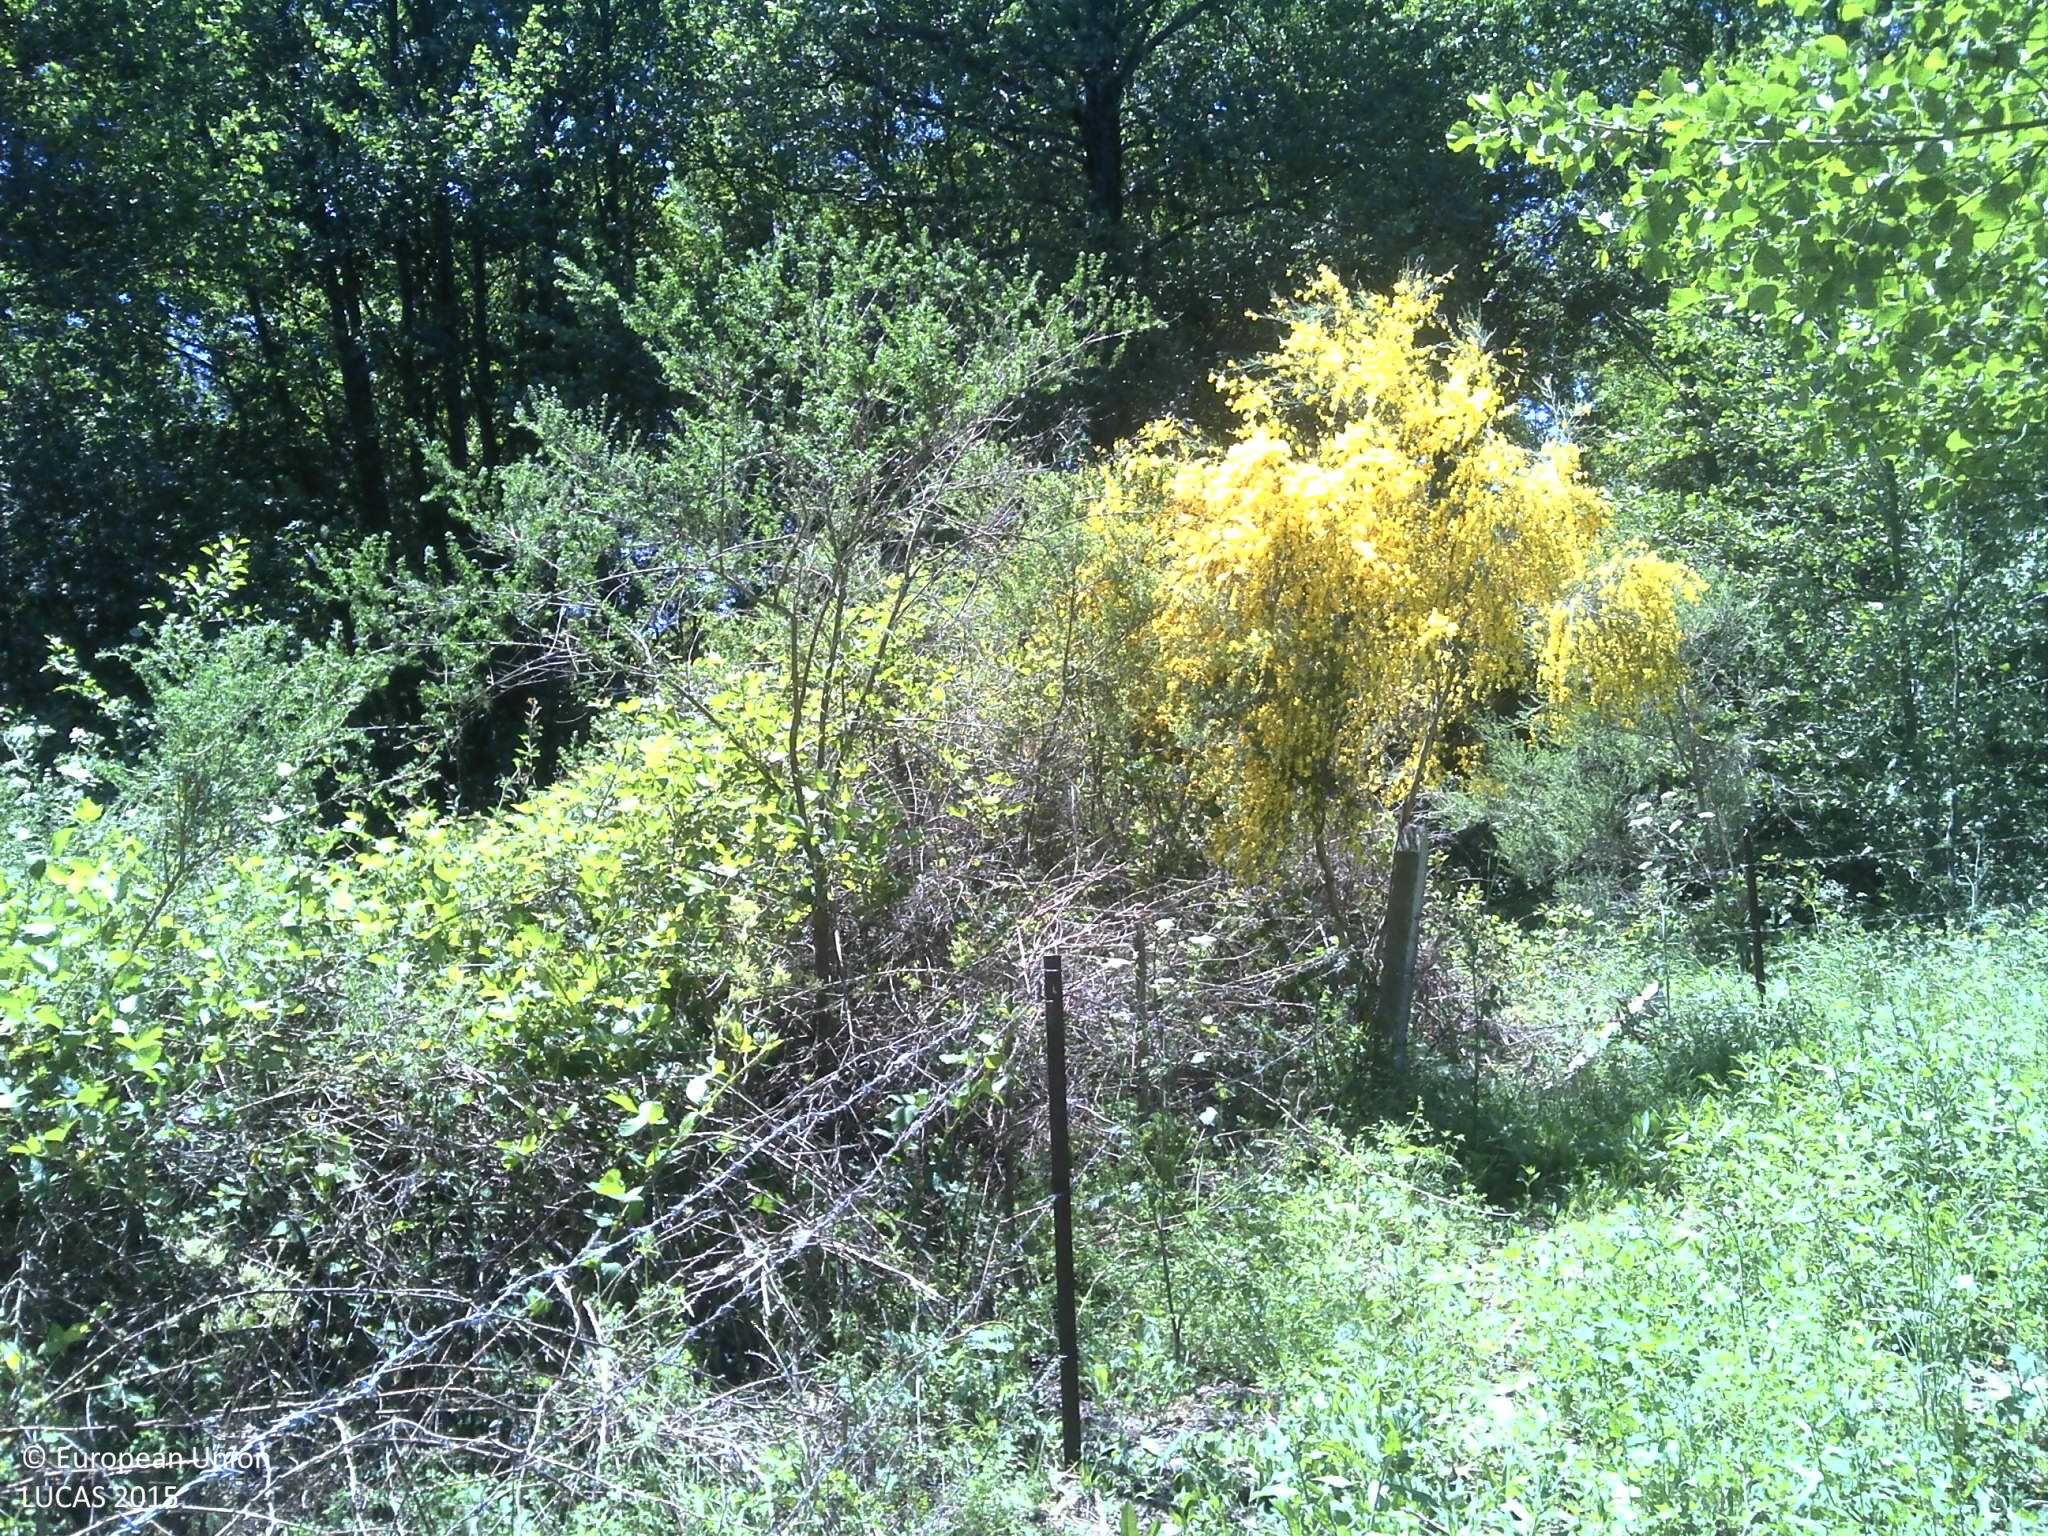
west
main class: Grassland
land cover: Grassland without tree/shrub cover
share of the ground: 50 - 75 %
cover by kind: herbaceous plants 65 %, consolidated bare surface 15 %, unconsolidated bare surface 15 %
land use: Agriculture (excluding fallow land and kitchen gardens)
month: May
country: PT
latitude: 40.5149
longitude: -7.2540
